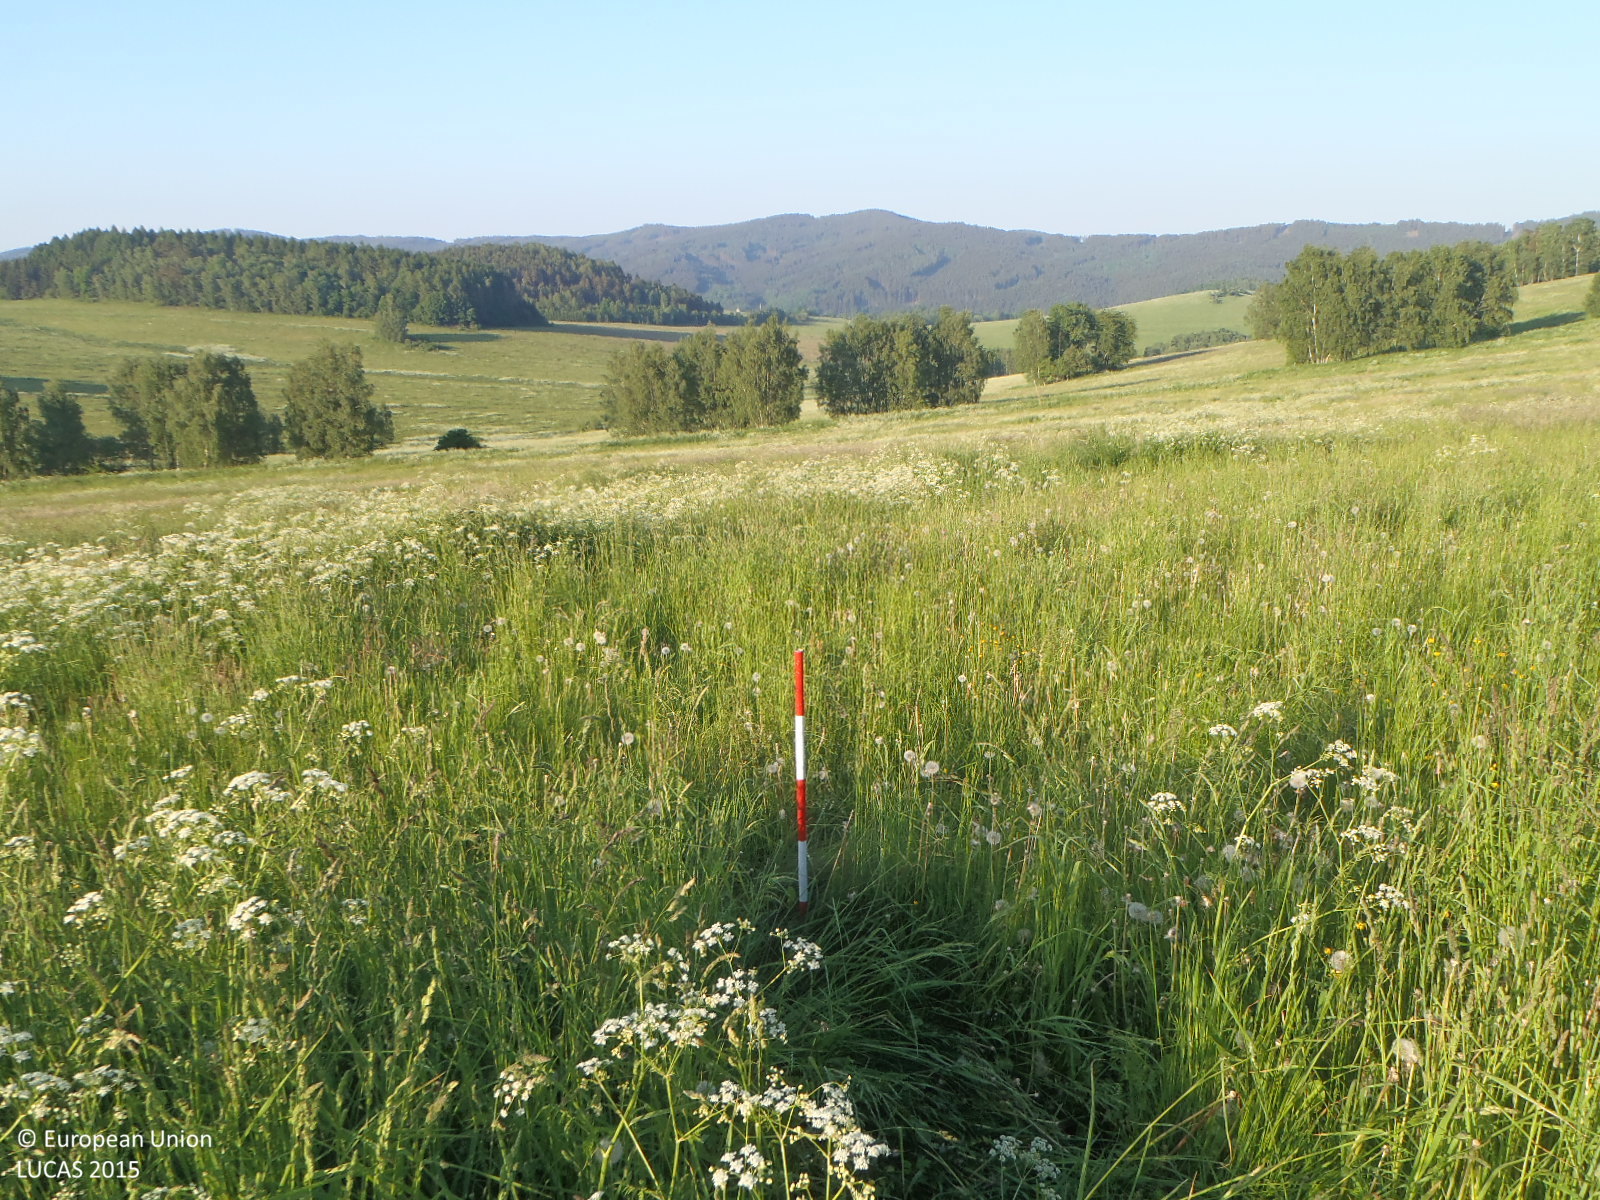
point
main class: Grassland
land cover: Grassland without tree/shrub cover
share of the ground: > 75 %
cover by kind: herbaceous plants 100 %
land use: Agriculture (excluding fallow land and kitchen gardens)
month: June
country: CZ
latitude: 48.6431
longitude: 14.3300
